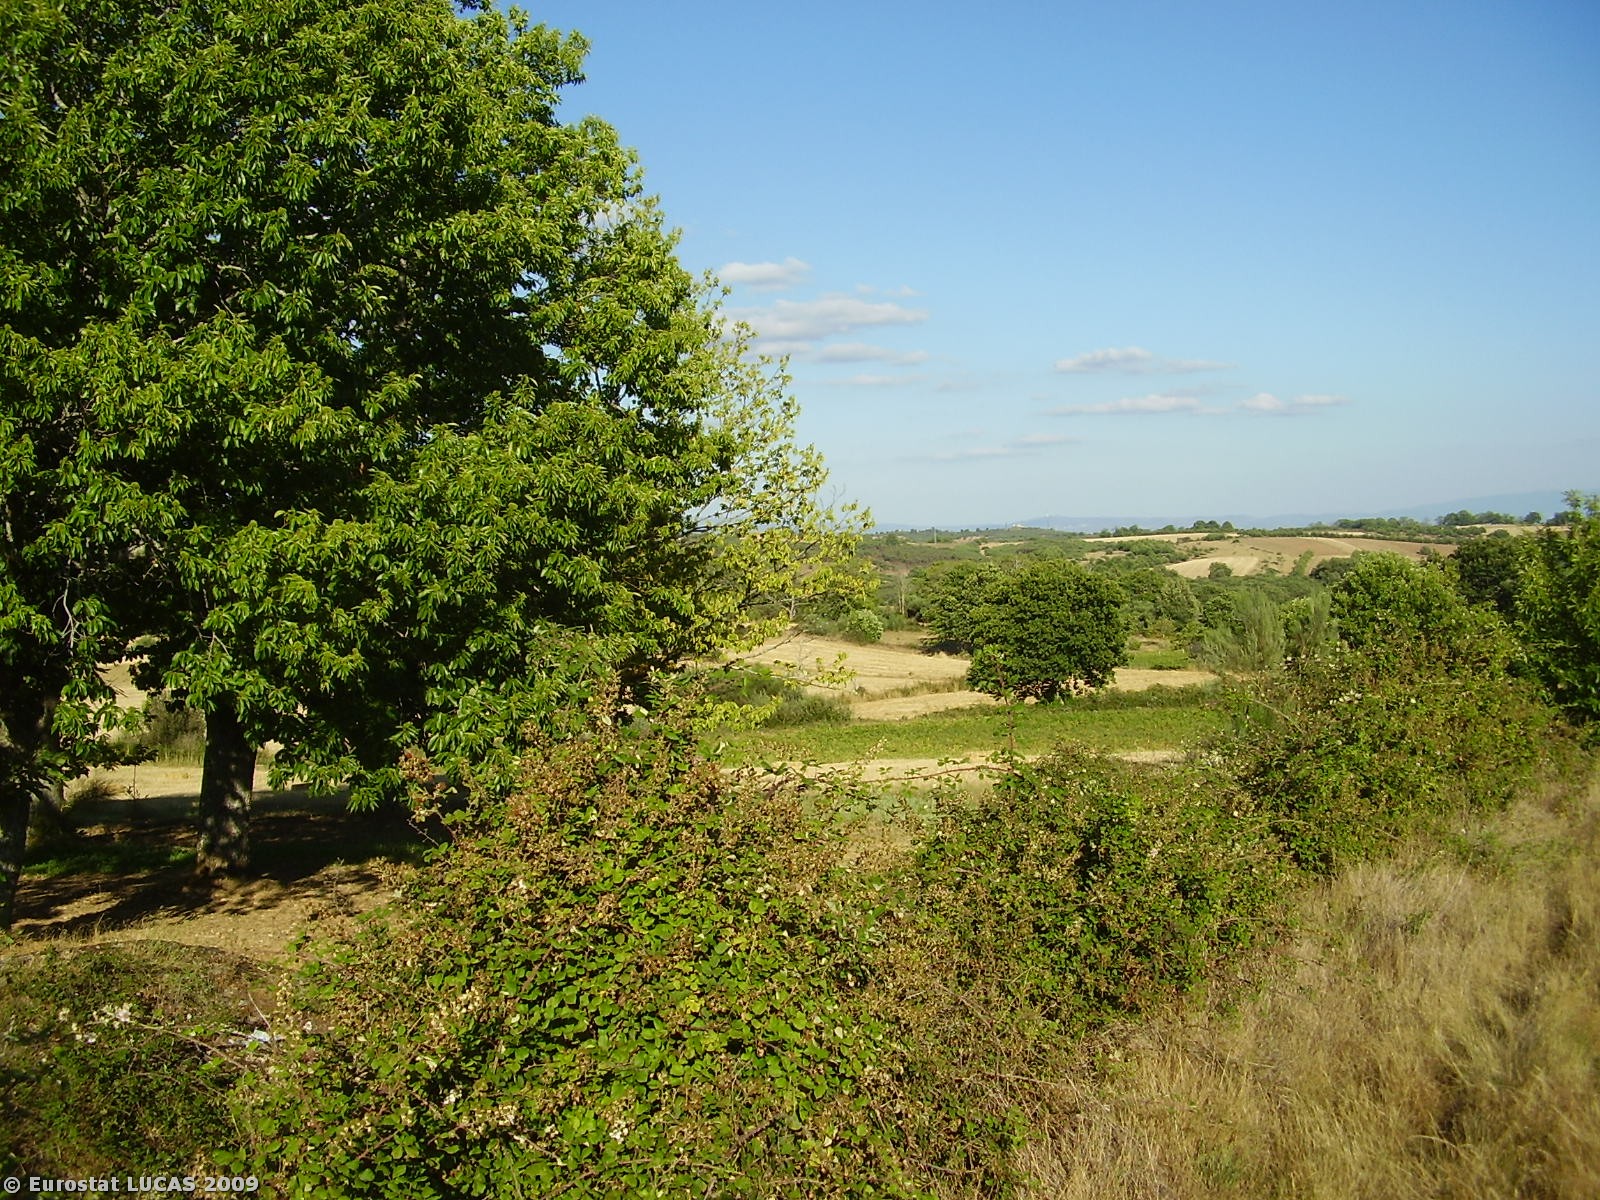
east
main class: Grassland
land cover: Spontaneously vegetated surfaces
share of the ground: > 75 %
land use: Unused
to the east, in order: Spontaneously vegetated surfaces; Shruby margins; Tracks; Nuts trees; Mixed cereals for fodder; Shruby margins; Abandoned hedges; Ditches and canals; Shruby margins; Abandoned hedges; Tracks; Shruby margins; Mixed cereals for fodder; Grass margins; Rye; Spontaneously vegetated surfaces
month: July
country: PT
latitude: 41.6887
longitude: -7.3920
